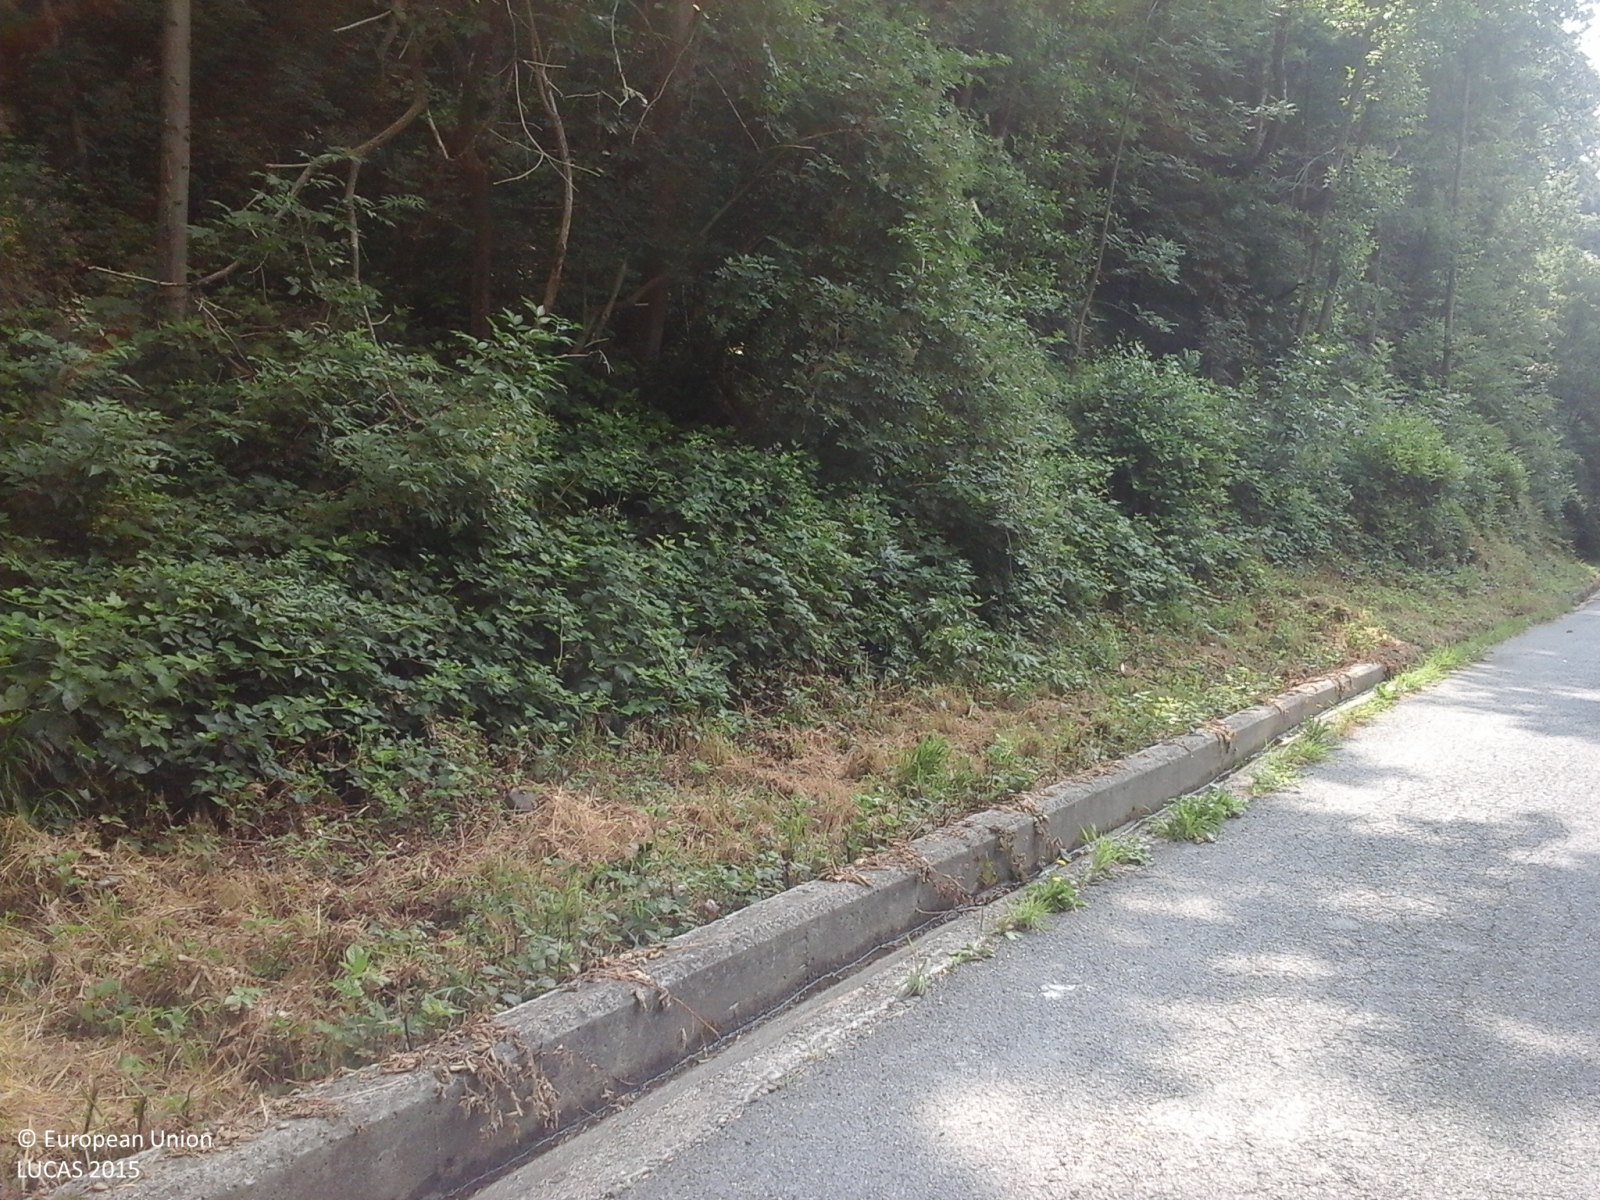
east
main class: Woodland
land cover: Broadleaved woodland
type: mesophytic deciduous forest
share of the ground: > 75 %
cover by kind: broadleaved forest trees 100 %
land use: Forestry
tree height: > 5 m
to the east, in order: Broadleaved woodland
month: July
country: IT
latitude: 45.0545
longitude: 7.2746
